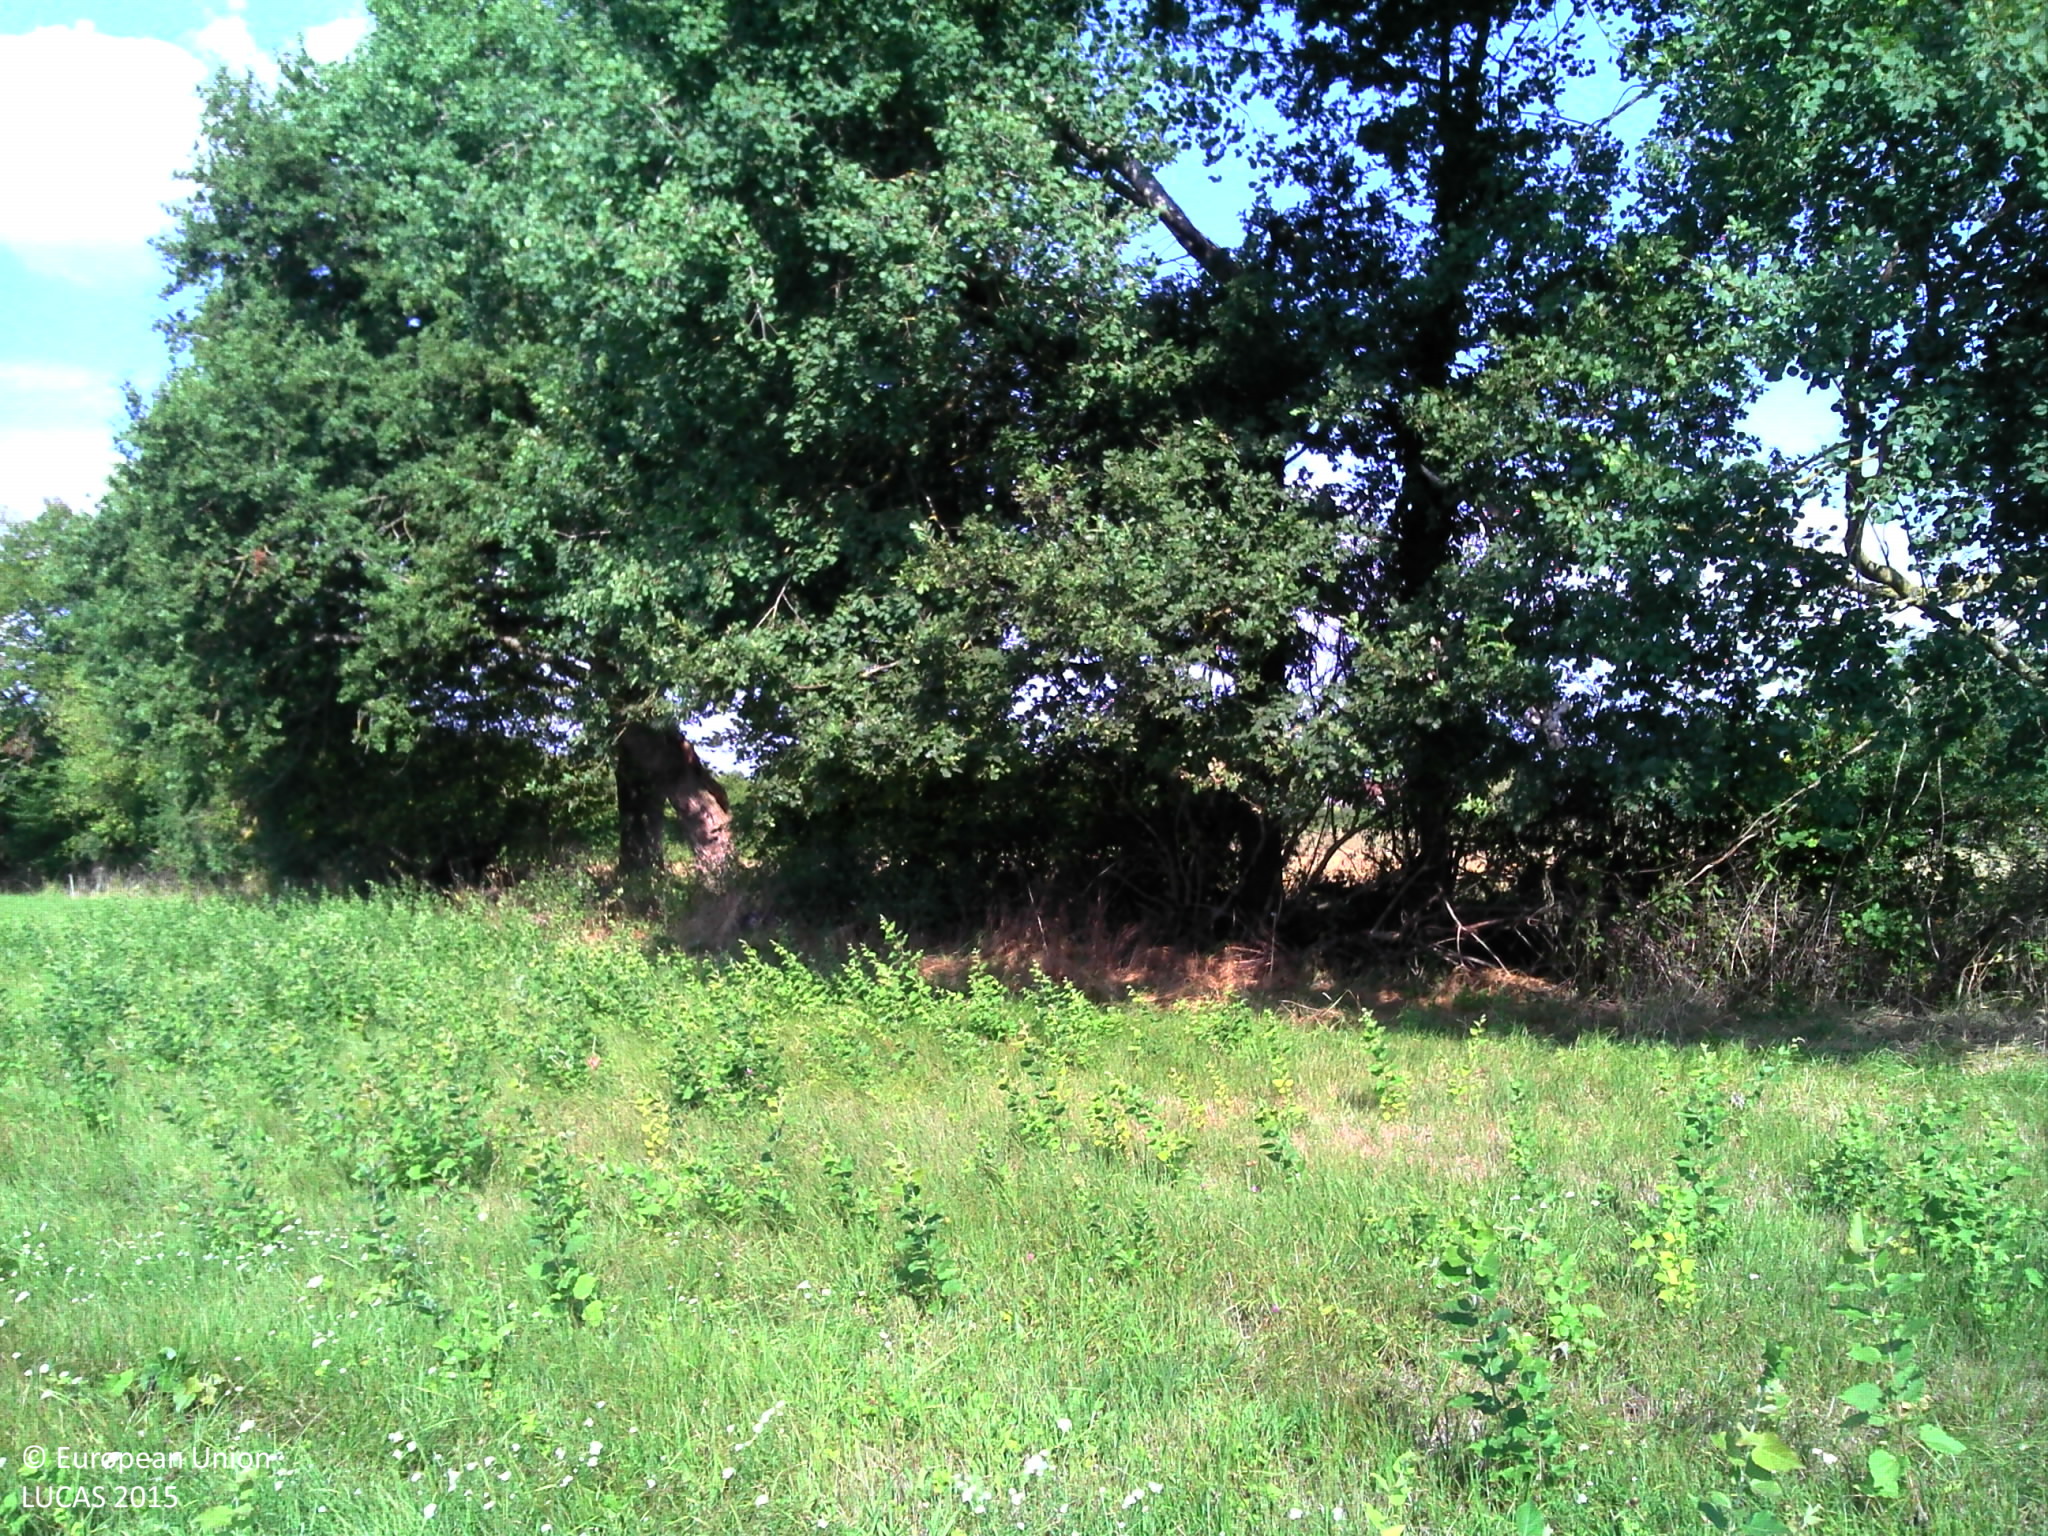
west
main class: Grassland
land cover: Grassland without tree/shrub cover
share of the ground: > 75 %
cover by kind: herbaceous plants 100 %
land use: Agriculture (excluding fallow land and kitchen gardens)
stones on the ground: < 10 %
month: August
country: FR
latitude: 46.7060
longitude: 2.8150
